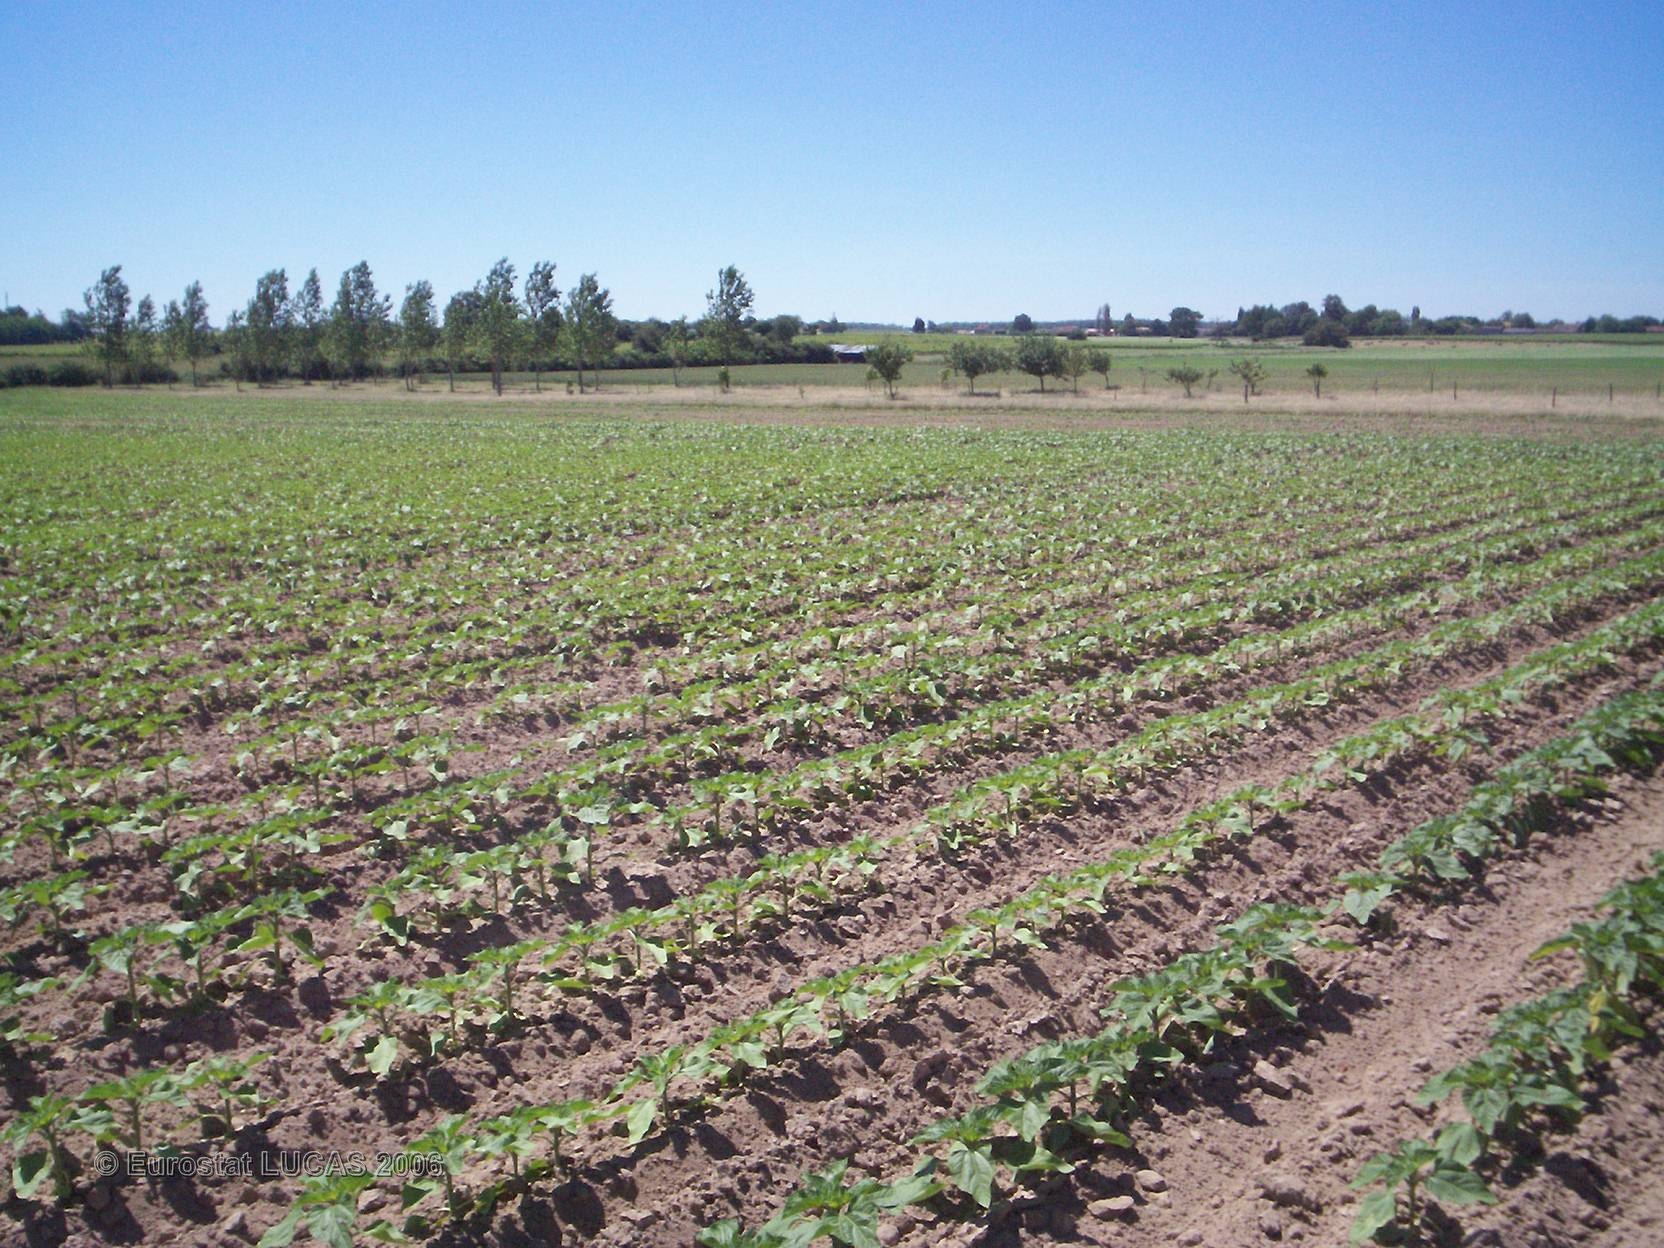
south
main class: Cropland
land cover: Sunflower
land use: Agriculture (excluding fallow land and kitchen gardens)
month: May
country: FR
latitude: 45.5005
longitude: -0.7356
